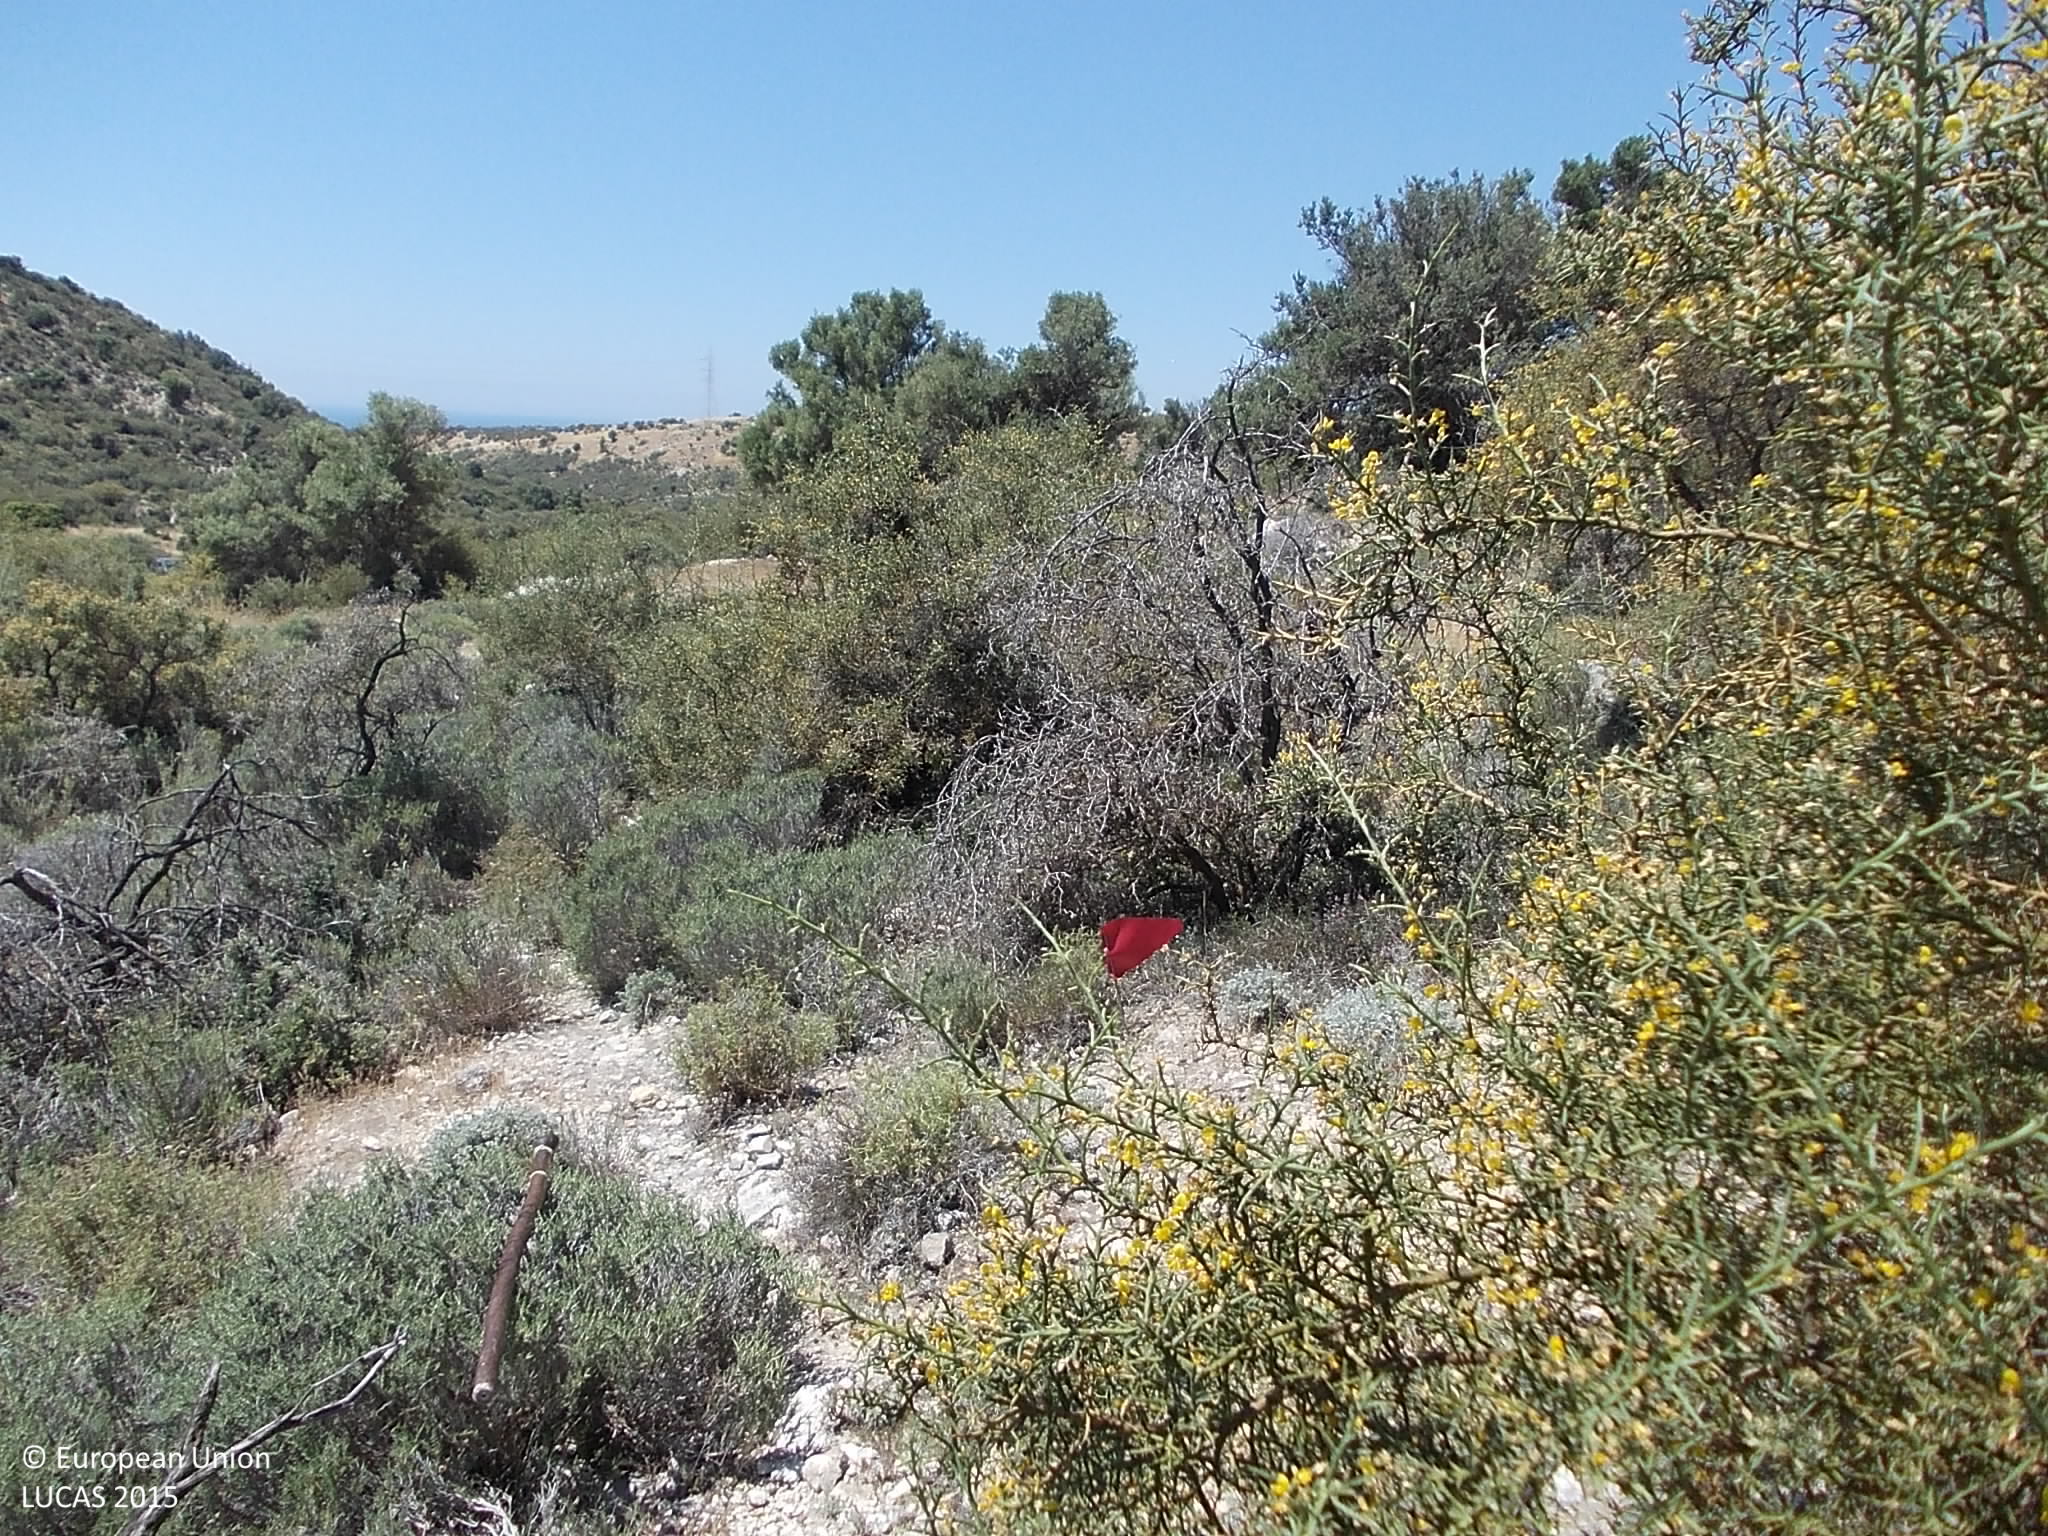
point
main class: Shrubland
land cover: Shrubland without tree cover
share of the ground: > 75 %
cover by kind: shrubs 80 %, unconsolidated bare surface 20 %
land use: Semi-natural and natural areas not in use
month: May
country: CY
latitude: 34.6984
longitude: 32.7862
